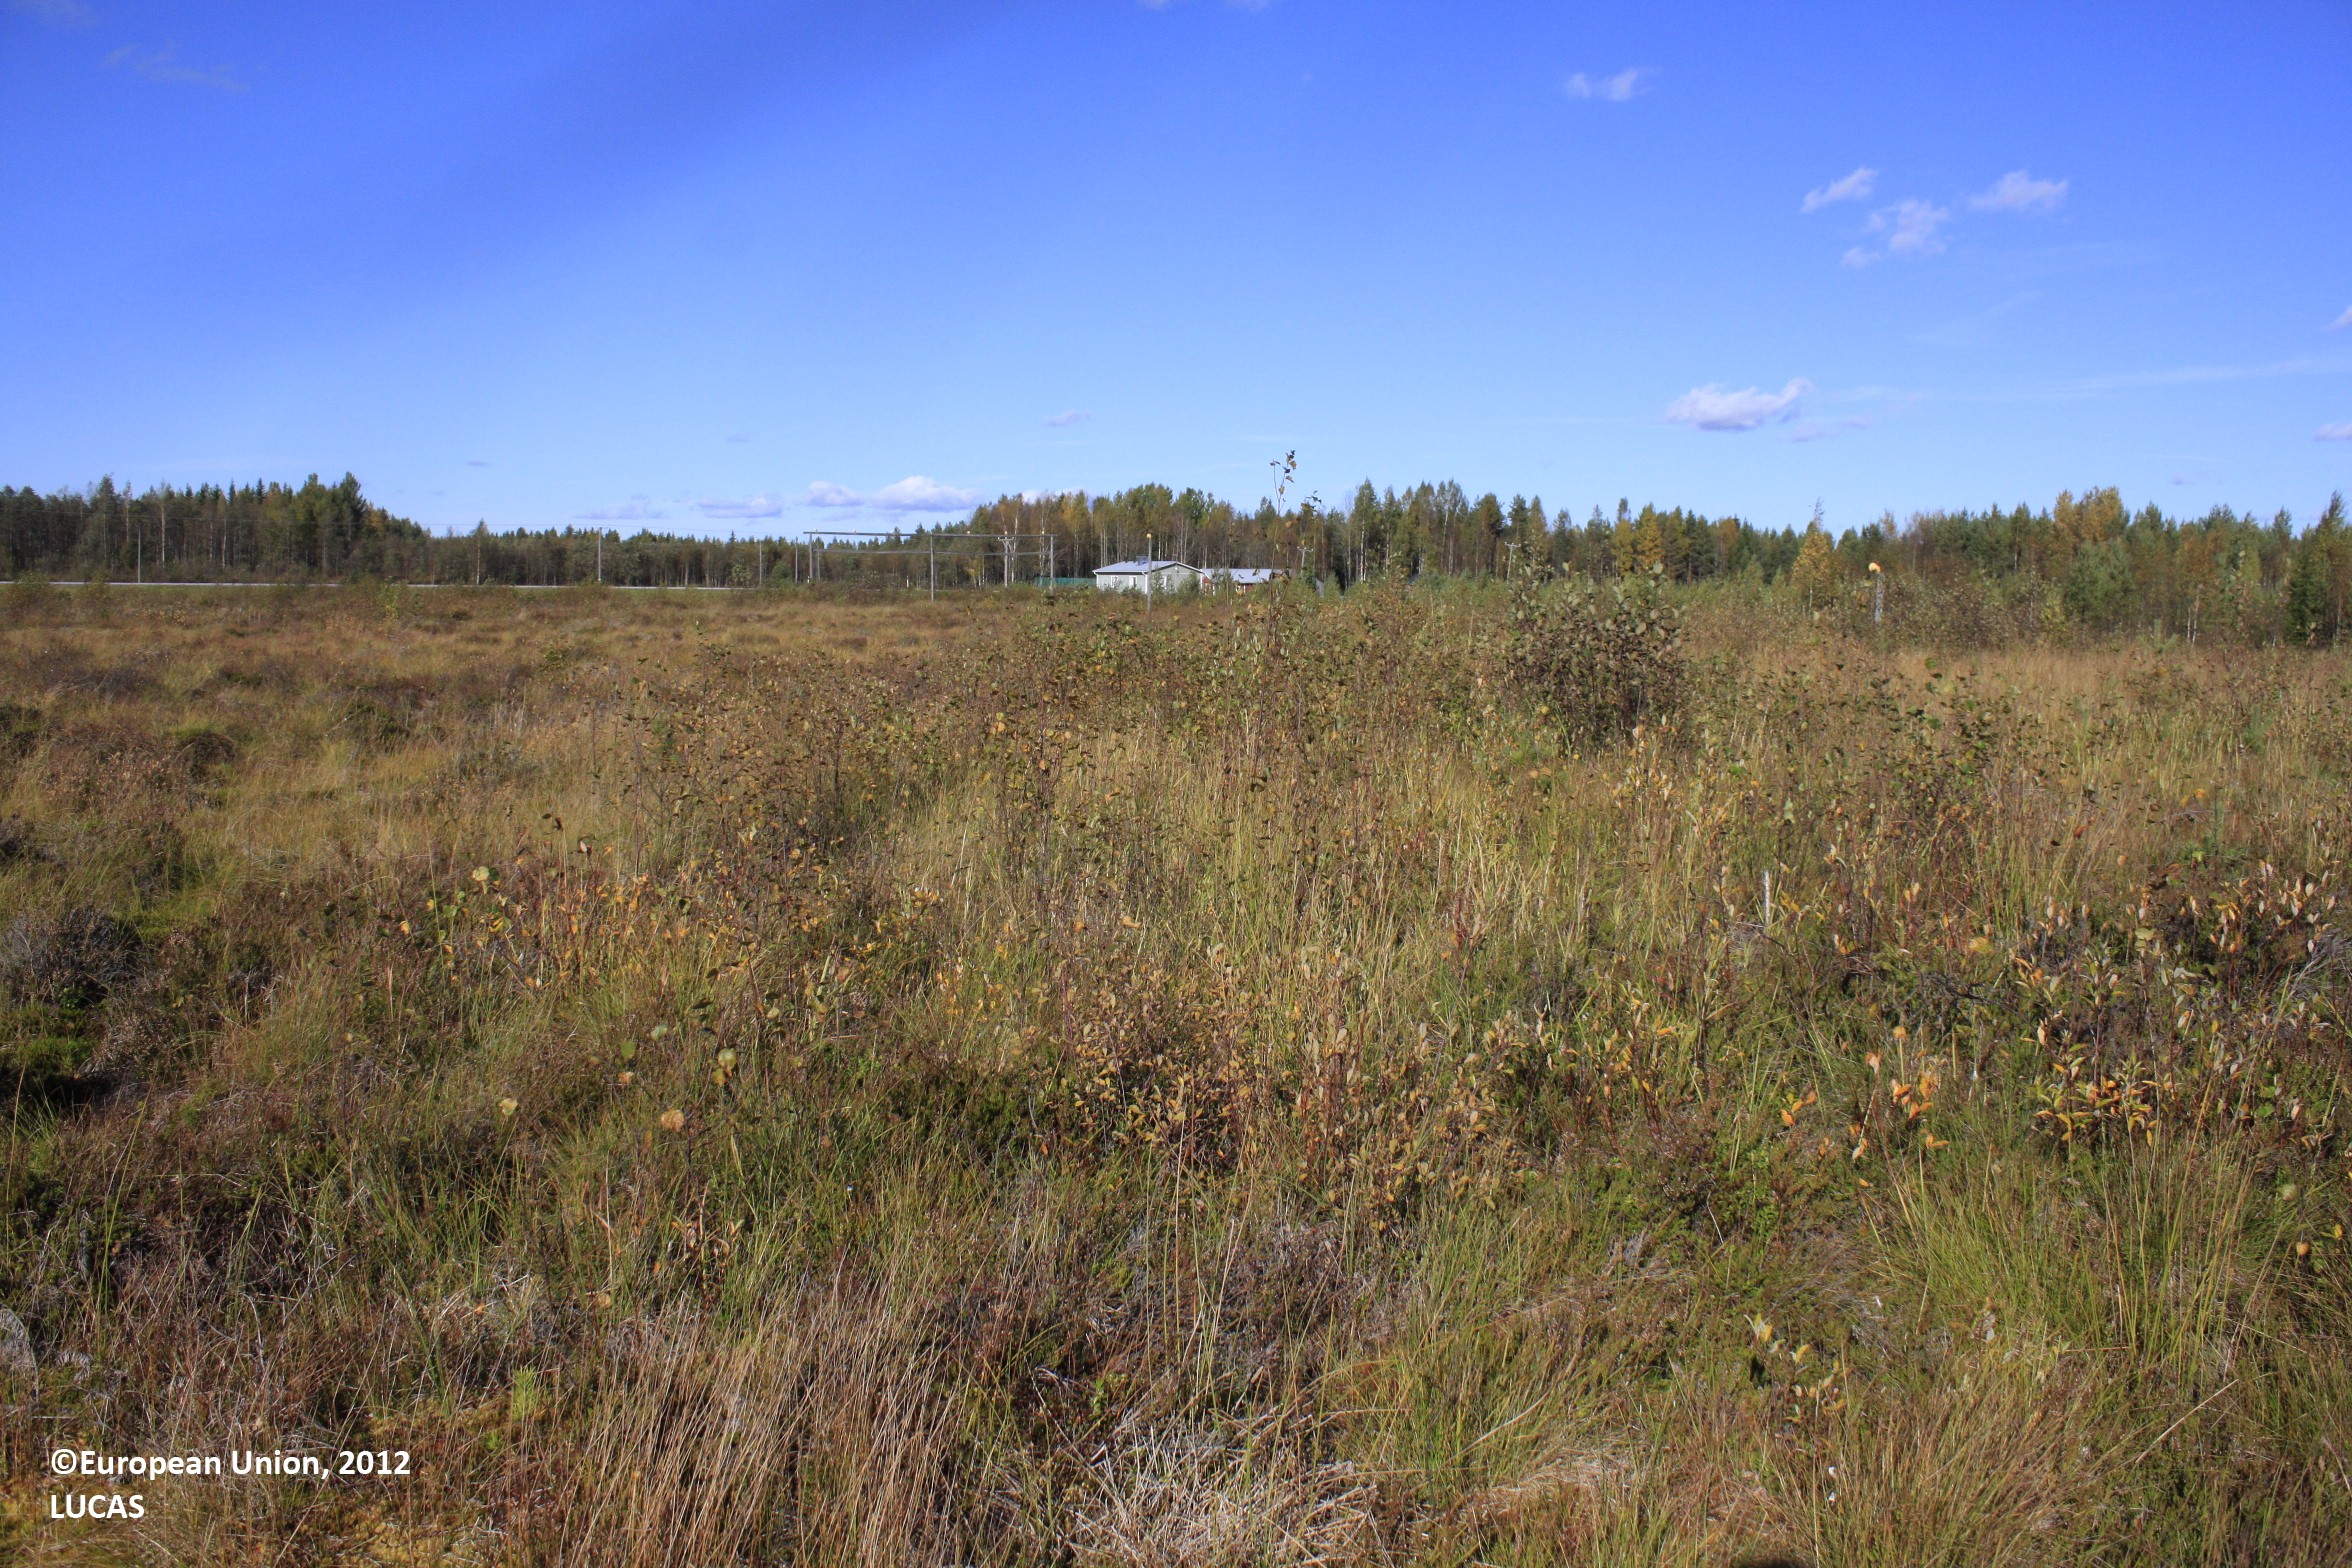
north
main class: Grassland
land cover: Grassland without tree/shrub cover
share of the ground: > 75 %
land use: Air transport
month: September
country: FI
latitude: 63.7339
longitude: 25.9271
